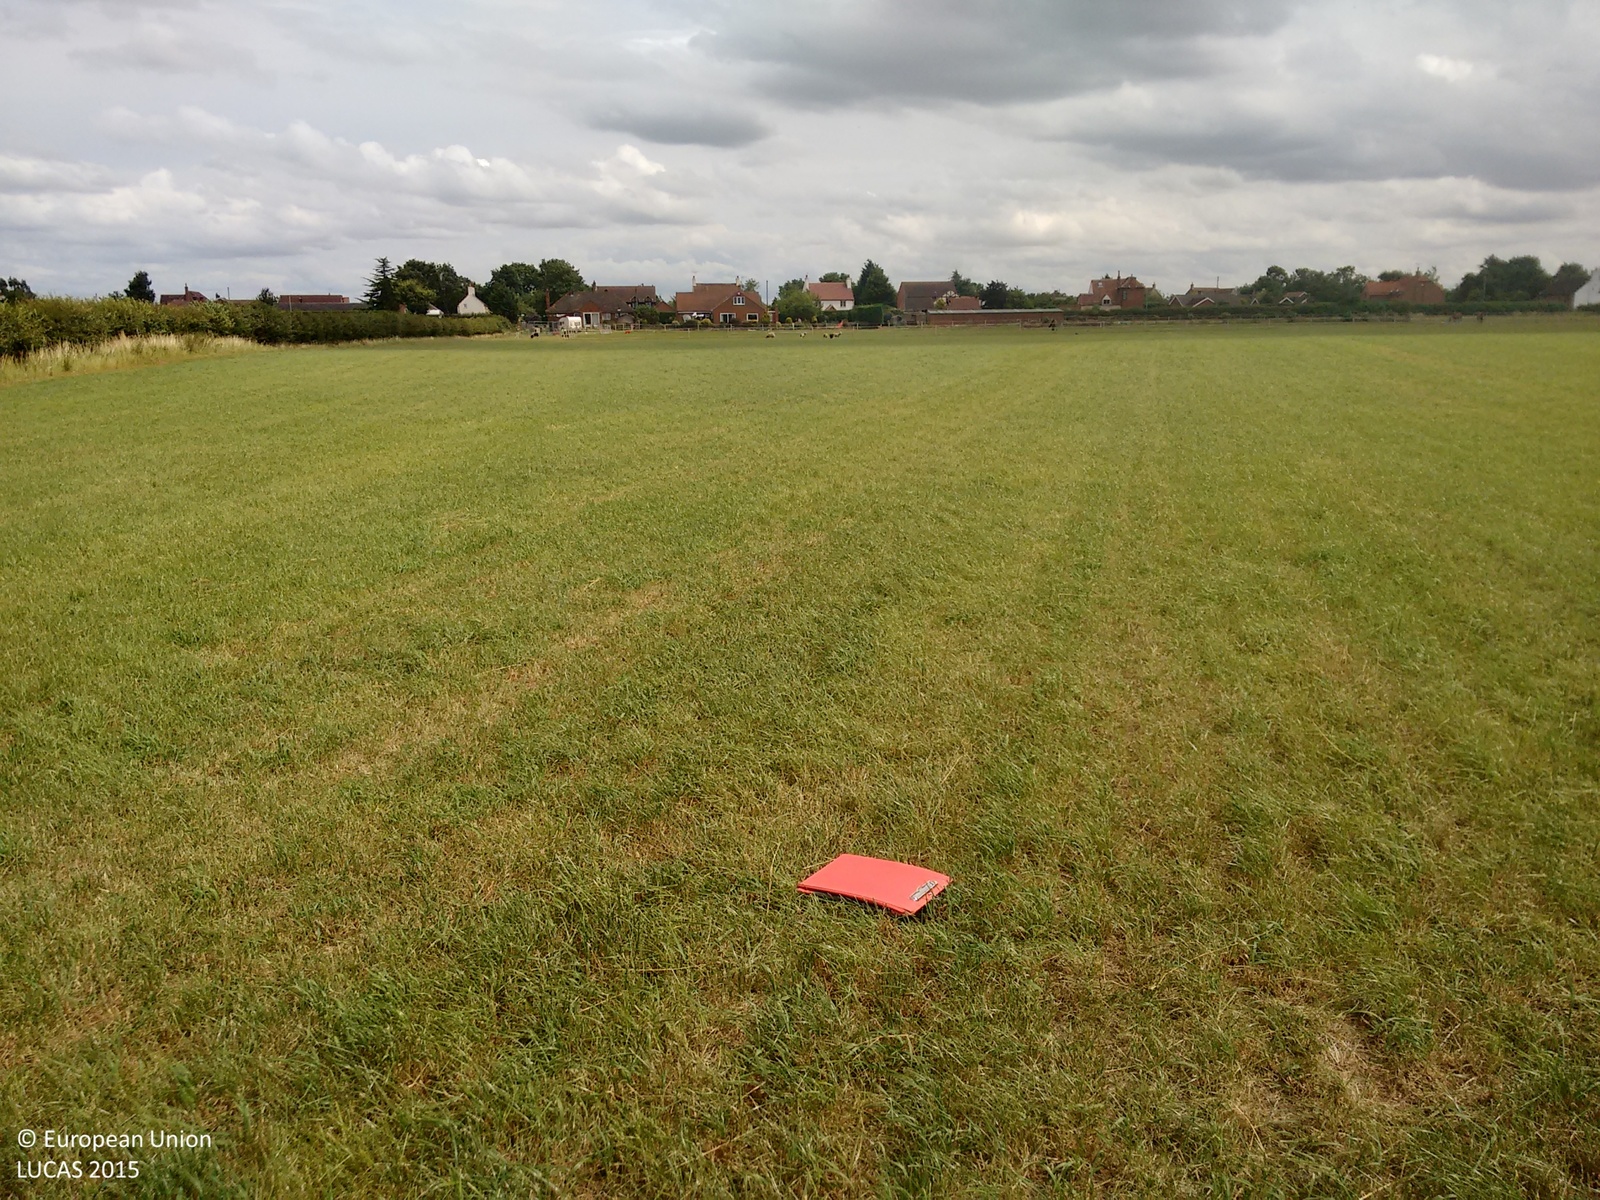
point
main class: Grassland
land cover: Grassland without tree/shrub cover
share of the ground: > 75 %
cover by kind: herbaceous plants 100 %
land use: Agriculture (excluding fallow land and kitchen gardens)
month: July
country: GB
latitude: 53.1158
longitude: -0.8136
